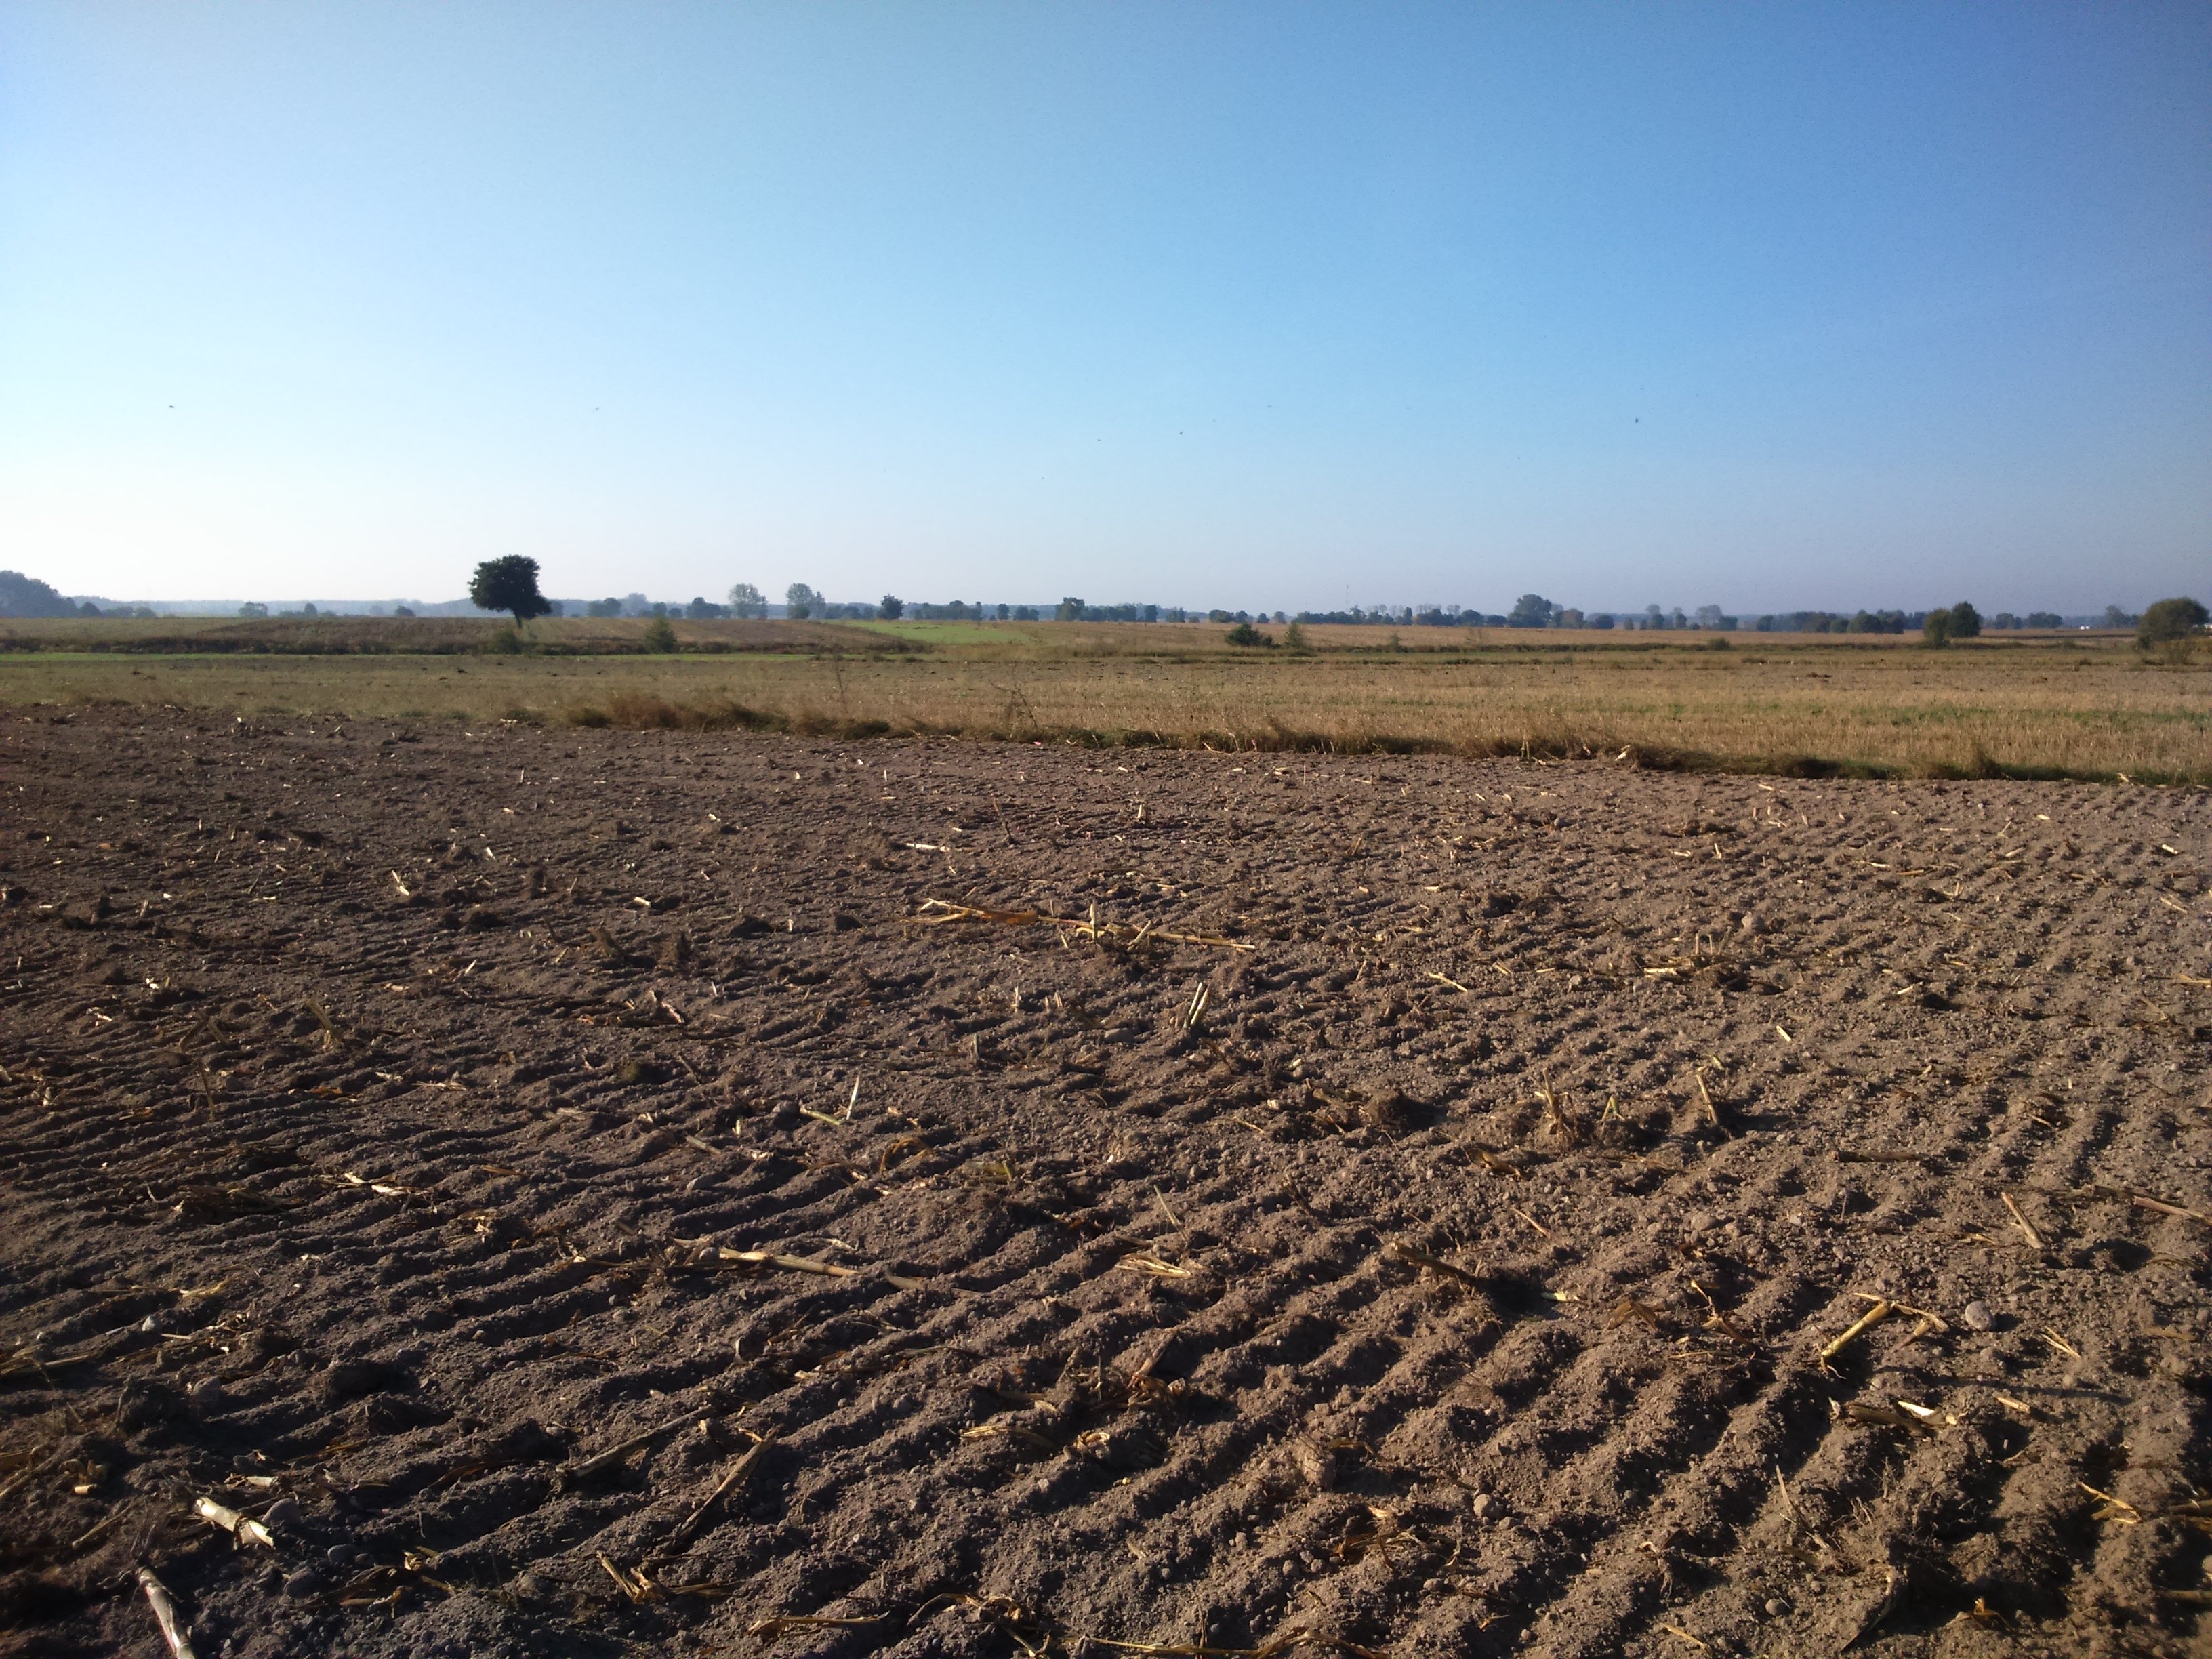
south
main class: Cropland
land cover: Maize
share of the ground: < 10 %
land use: Agriculture (excluding fallow land and kitchen gardens)
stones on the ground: < 10 %
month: September
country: PL
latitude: 52.4813
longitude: 22.1195
